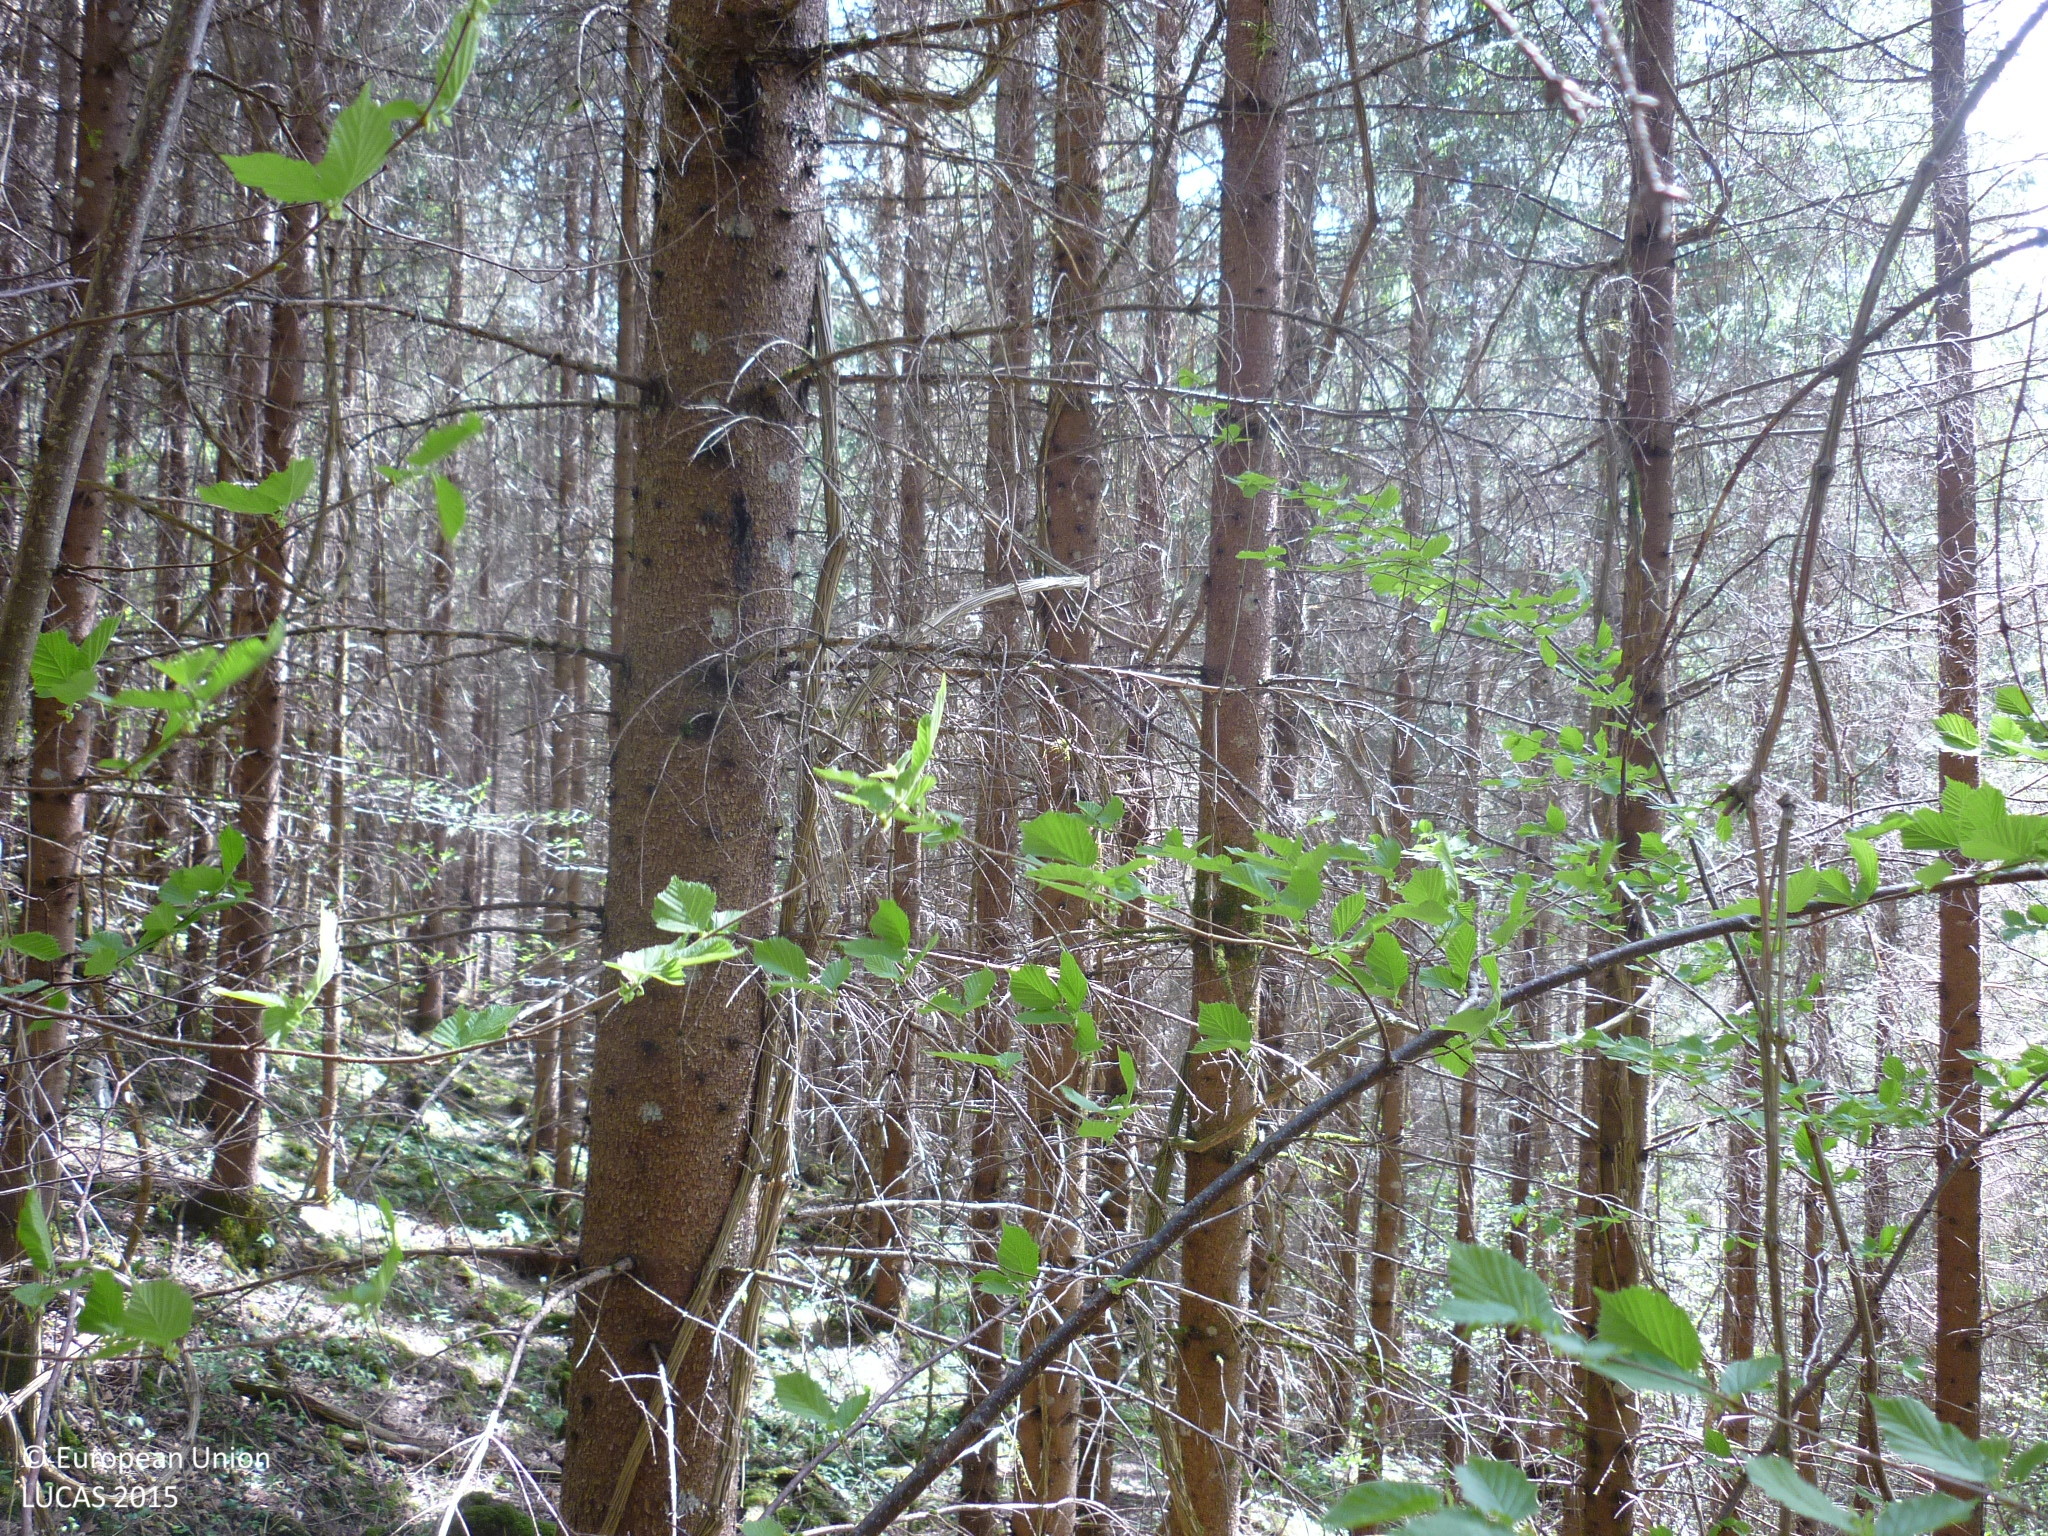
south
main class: Woodland
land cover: Spruce dominated coniferous woodland
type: alpine coniferous forest
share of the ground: > 75 %
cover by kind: coniferous forest trees 95 %, broadleaved forest trees 5 %
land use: Forestry
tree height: > 5 m
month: May
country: AT
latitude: 47.7039
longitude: 14.8109
